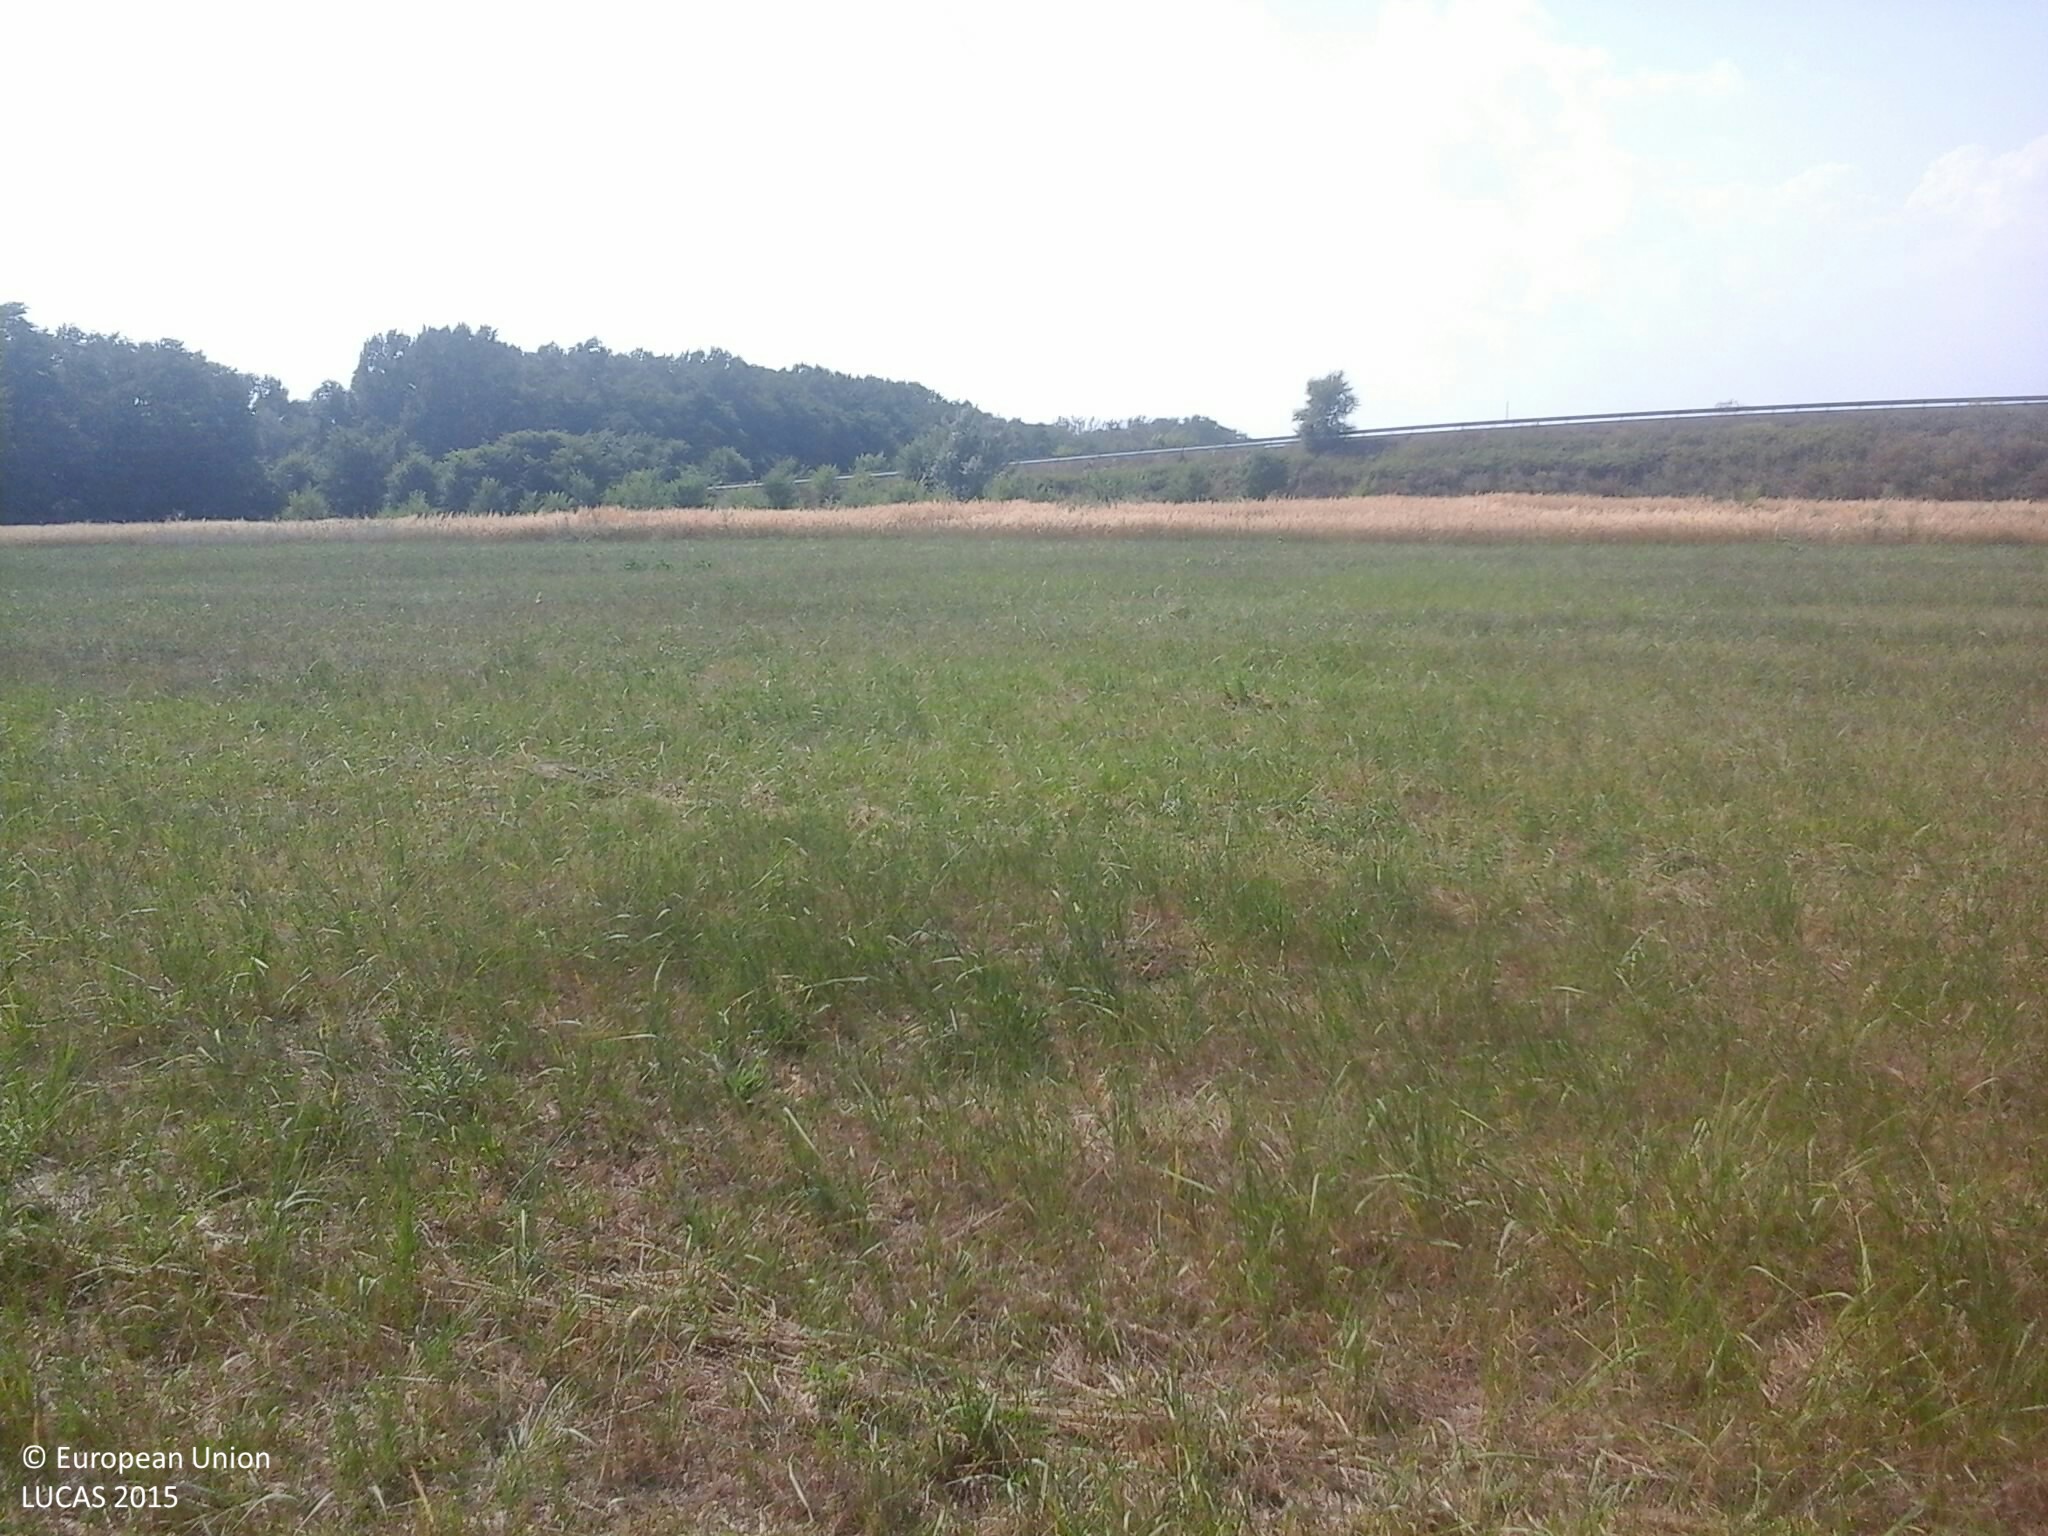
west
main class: Grassland
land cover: Grassland without tree/shrub cover
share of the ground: > 75 %
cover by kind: herbaceous plants 100 %
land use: Agriculture (excluding fallow land and kitchen gardens)
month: August
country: HU
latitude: 47.4144
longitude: 19.2837
